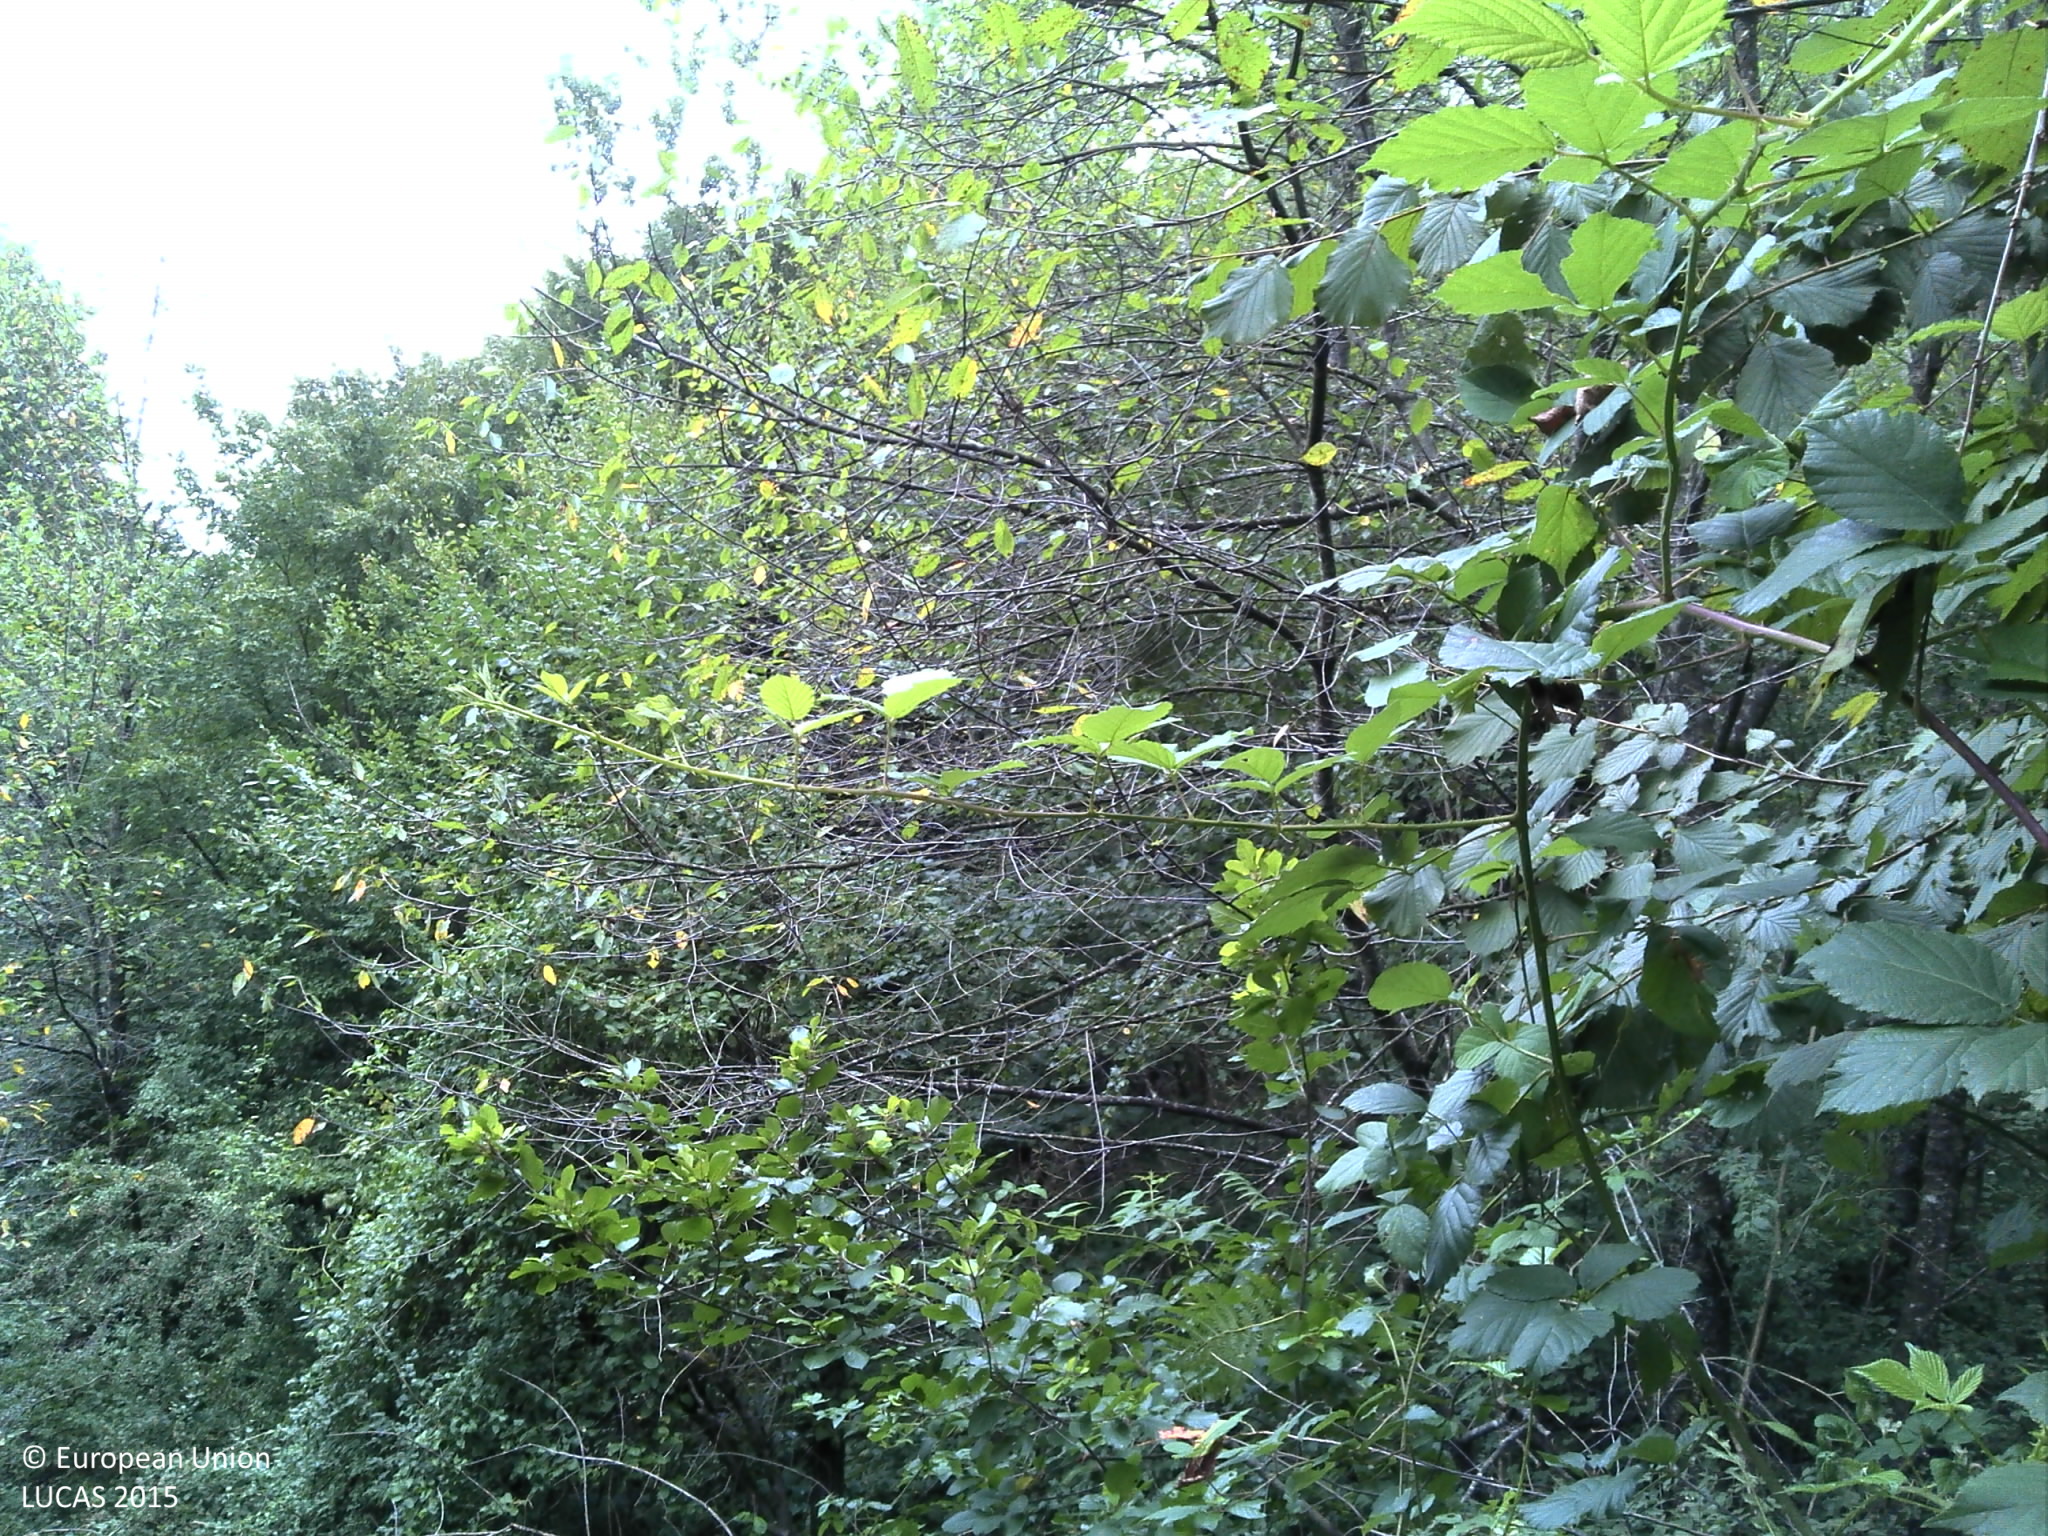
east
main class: Woodland
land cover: Broadleaved woodland
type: mesophytic deciduous forest
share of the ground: 50 - 75 %
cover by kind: broadleaved forest trees 75 %, shrubs 20 %, herbaceous plants 5 %
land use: Semi-natural and natural areas not in use
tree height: > 5 m
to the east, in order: Broadleaved woodland
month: August
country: HR
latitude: 45.3337
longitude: 15.6743
